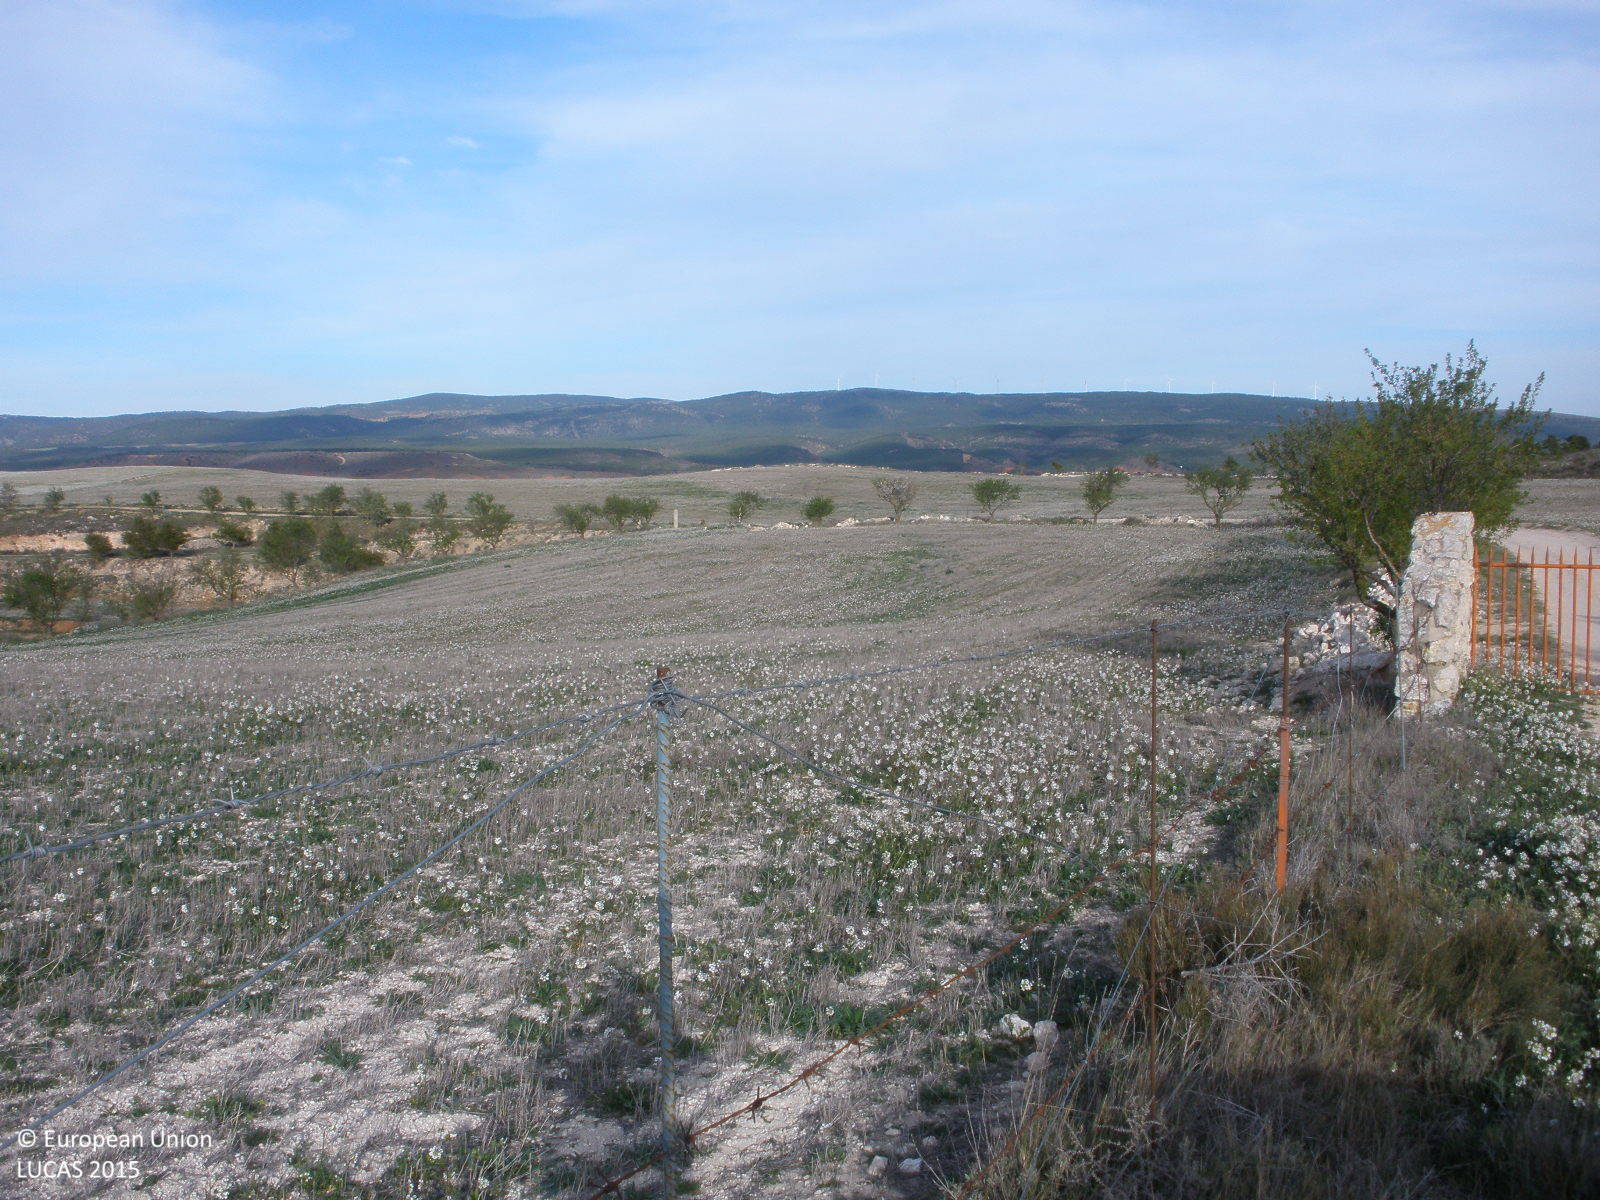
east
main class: Grassland
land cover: Spontaneously vegetated surfaces
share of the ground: > 75 %
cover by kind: herbaceous plants 70 %, unconsolidated bare surface 30 %
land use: Agriculture (excluding fallow land and kitchen gardens)
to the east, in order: Spontaneously vegetated surfaces; Permanent crops (only in case pi); Abandoned hedges; Artificial constructions in urban areas
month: April
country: ES
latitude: 40.3508
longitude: -1.0659
